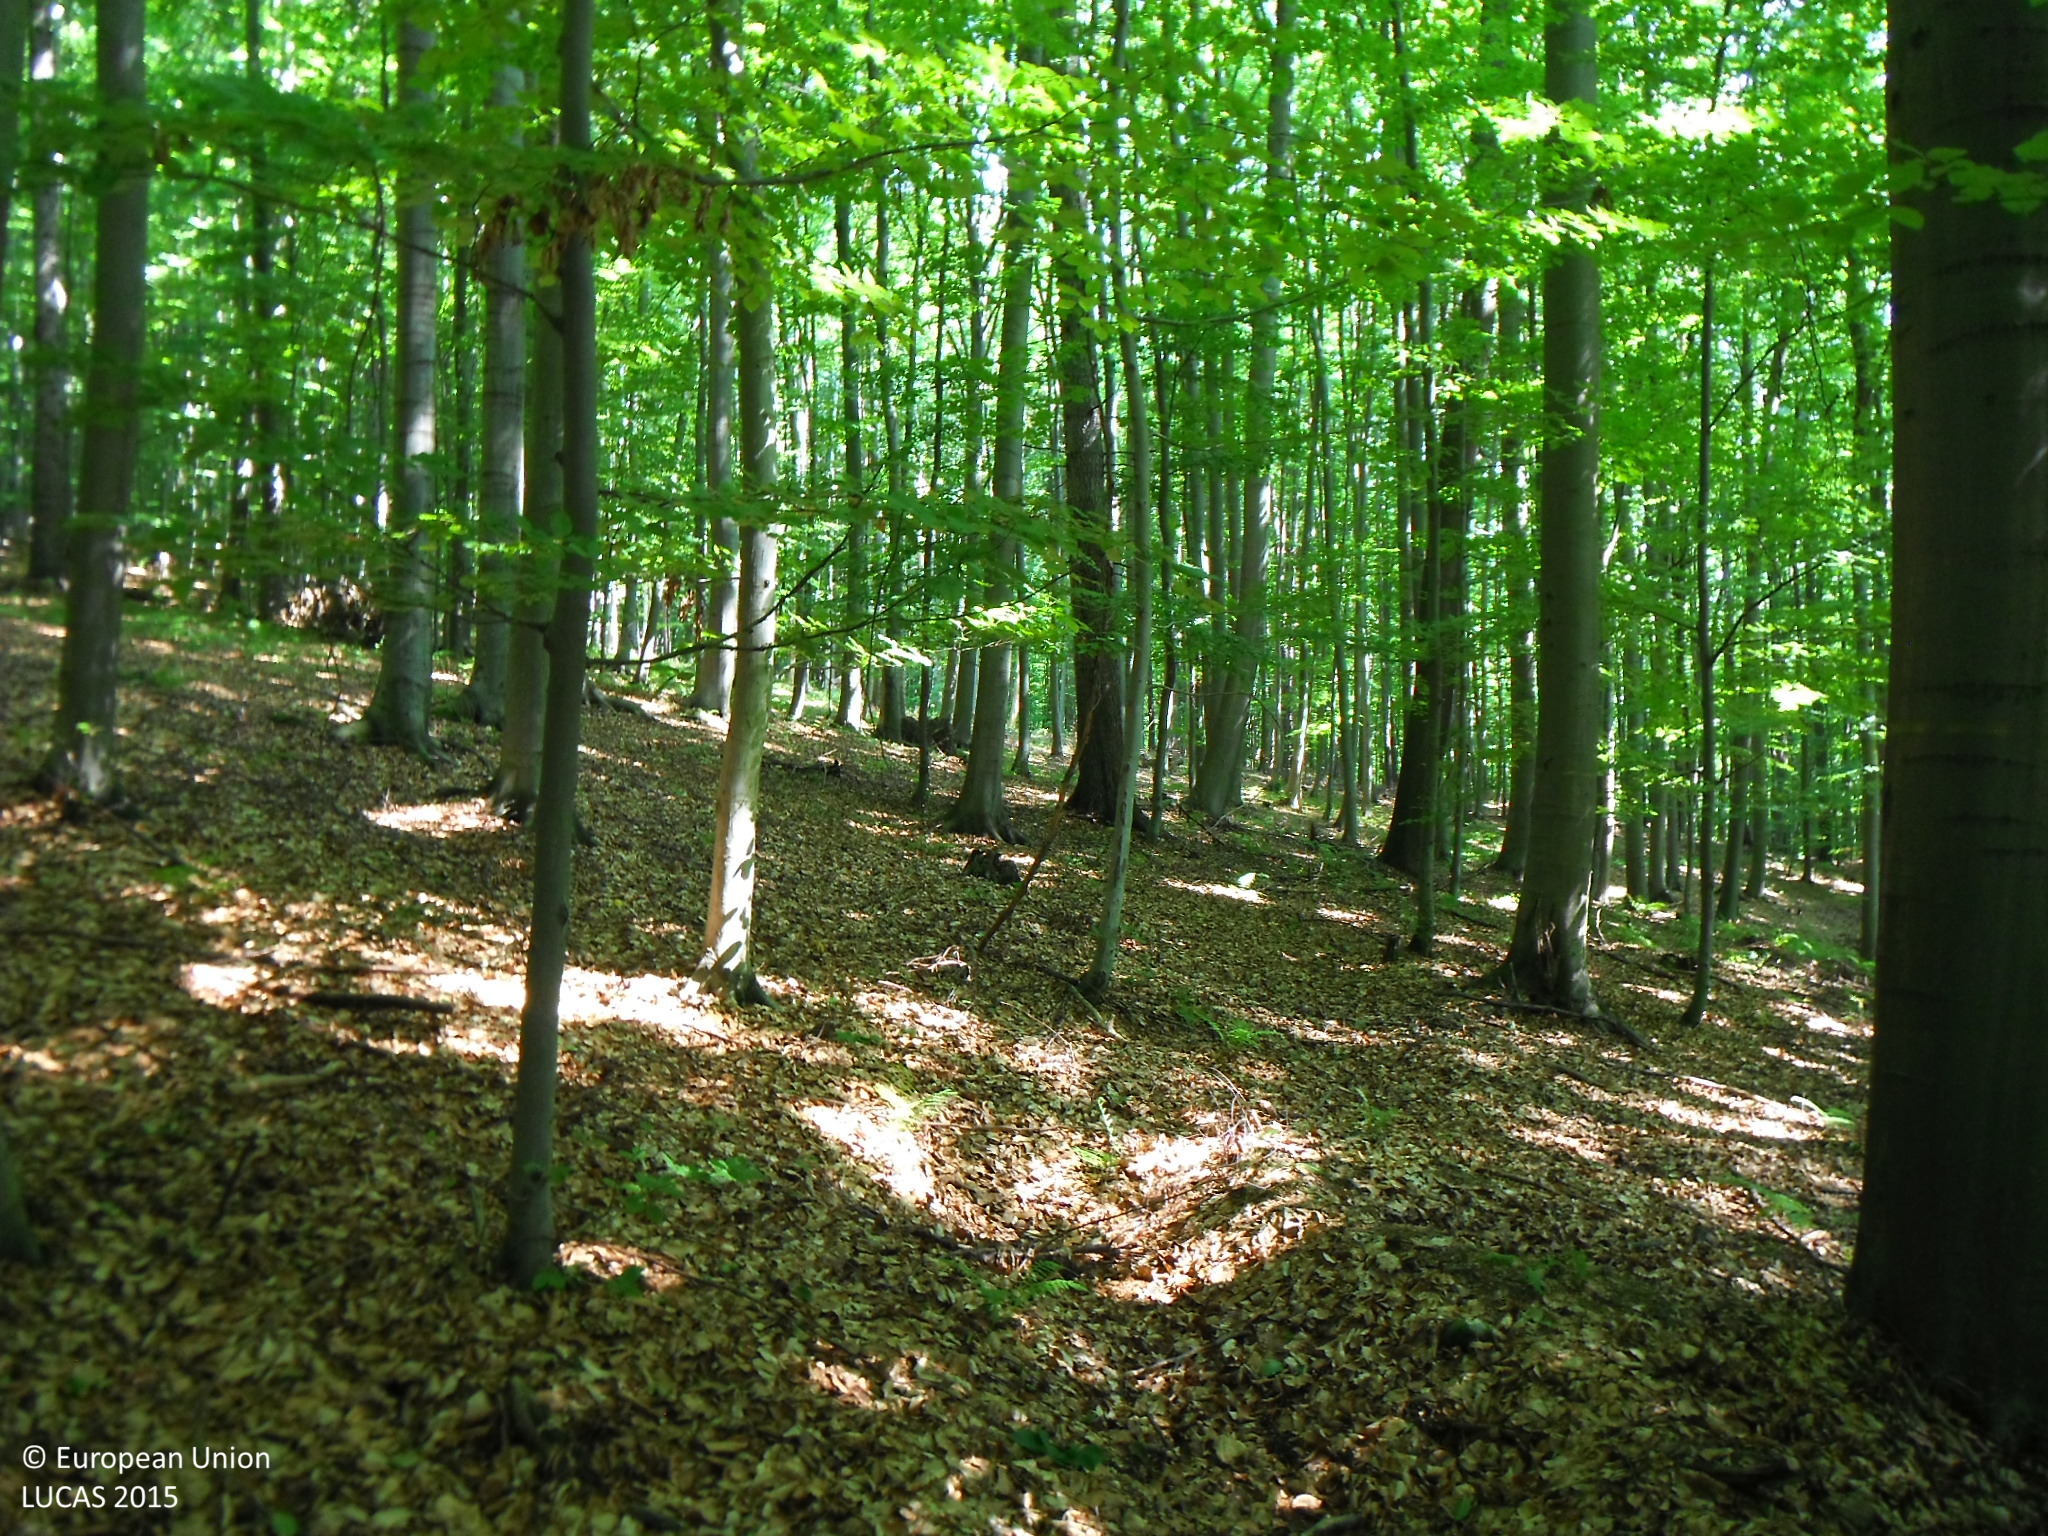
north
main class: Woodland
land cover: Broadleaved woodland
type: mesophytic deciduous forest
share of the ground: > 75 %
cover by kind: broadleaved forest trees 80 %, coniferous forest trees 20 %
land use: Forestry
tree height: > 5 m
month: July
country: SK
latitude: 49.2628
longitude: 21.2449
